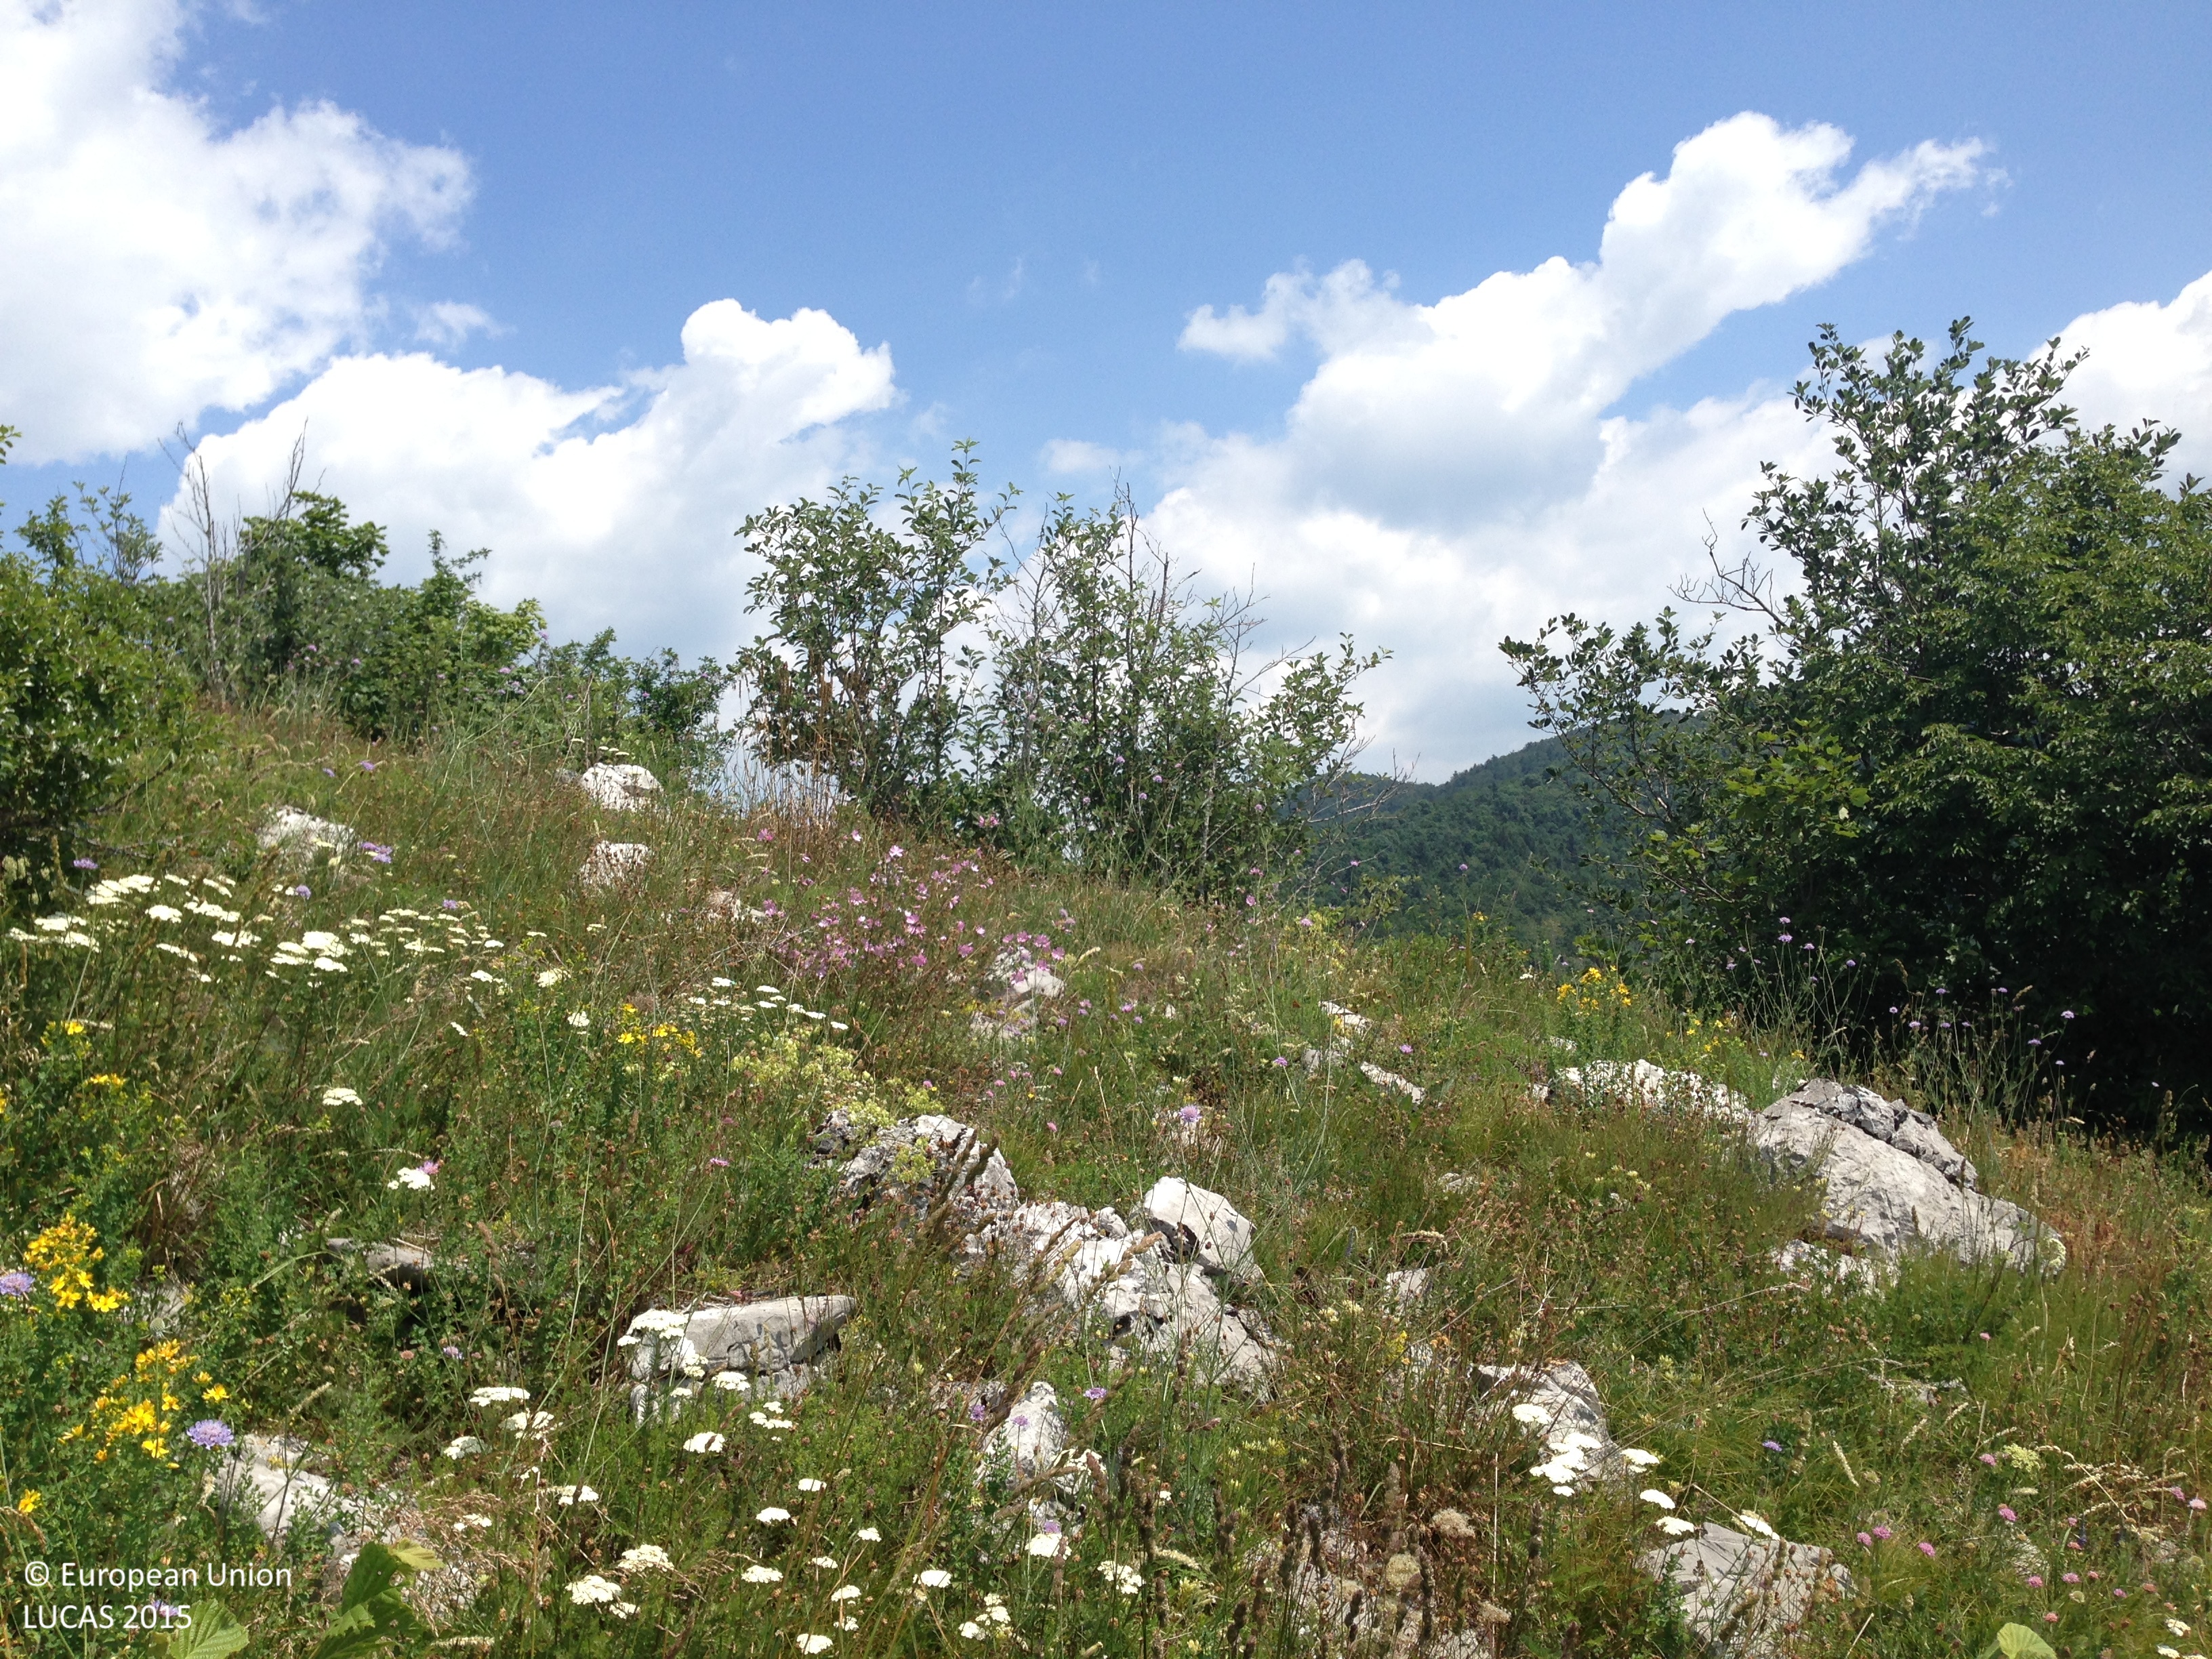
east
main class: Shrubland
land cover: Shrubland with sparse tree cover
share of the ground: 25 - 50 %
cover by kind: shrubs 35 %, herbaceous plants 35 %, consolidated bare surface 20 %, broadleaved forest trees 5 %, unconsolidated bare surface 5 %
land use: Semi-natural and natural areas not in use
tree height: < 5 m
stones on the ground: < 10 %
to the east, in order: Shrubland with sparse tree cover; Tracks; Other coniferous woodland
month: July
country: HR
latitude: 44.5843
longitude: 15.1447
